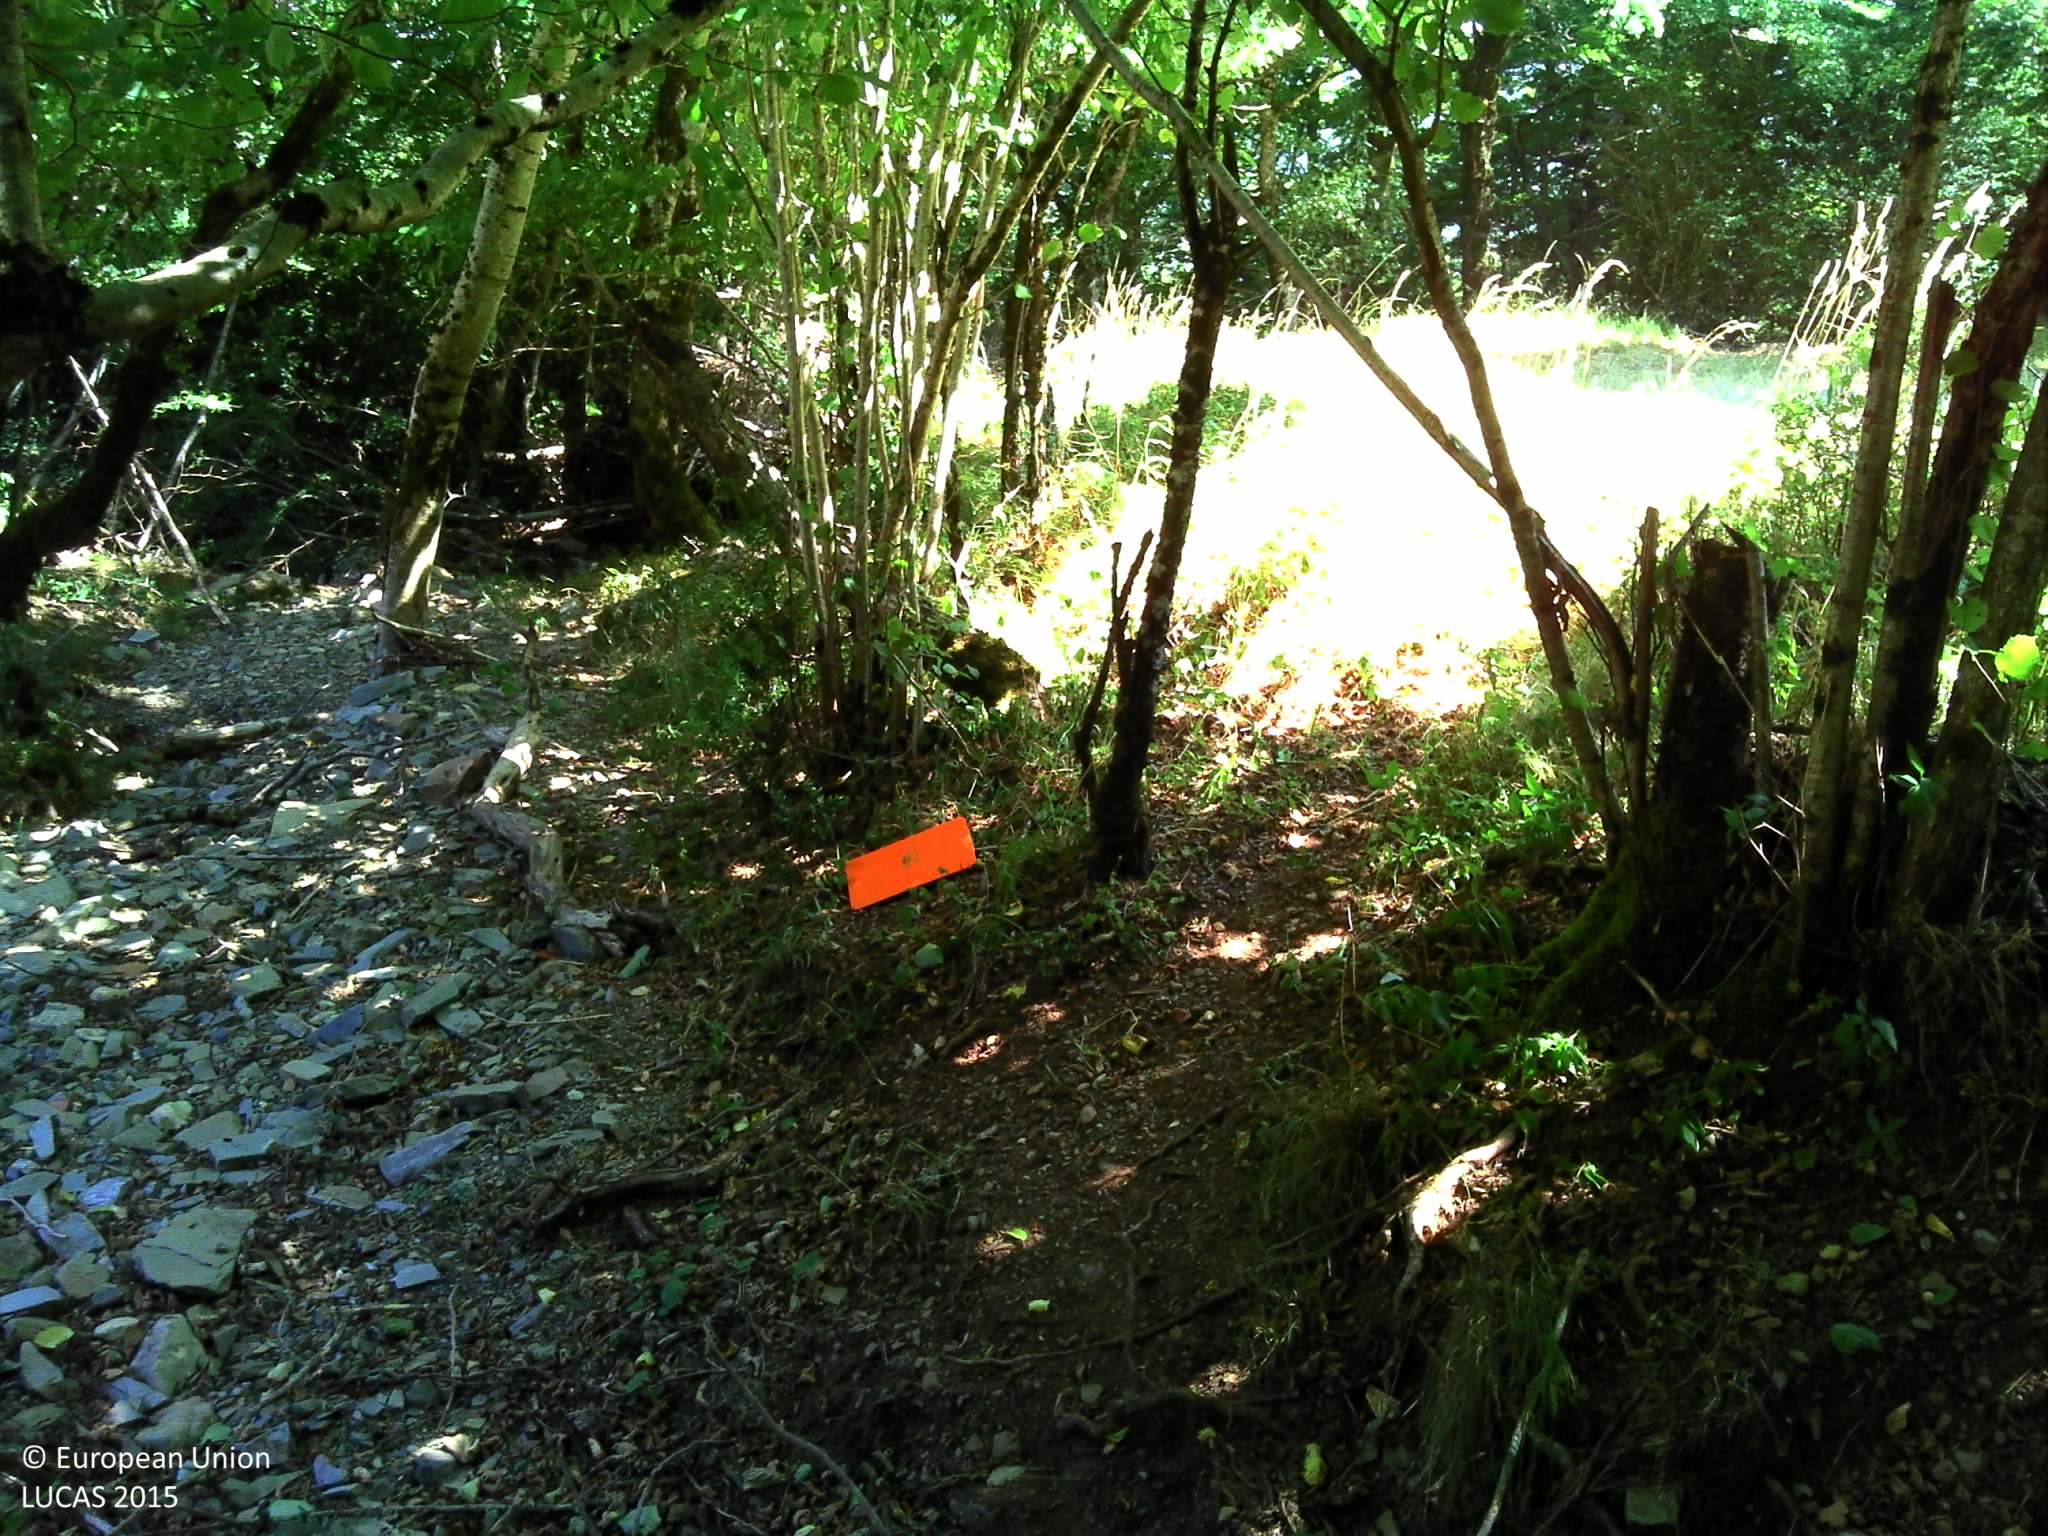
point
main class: Cropland
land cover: Temporary grasslands
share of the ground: > 75 %
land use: Agriculture (excluding fallow land and kitchen gardens)
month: August
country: FR
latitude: 43.7188
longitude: 3.0441
